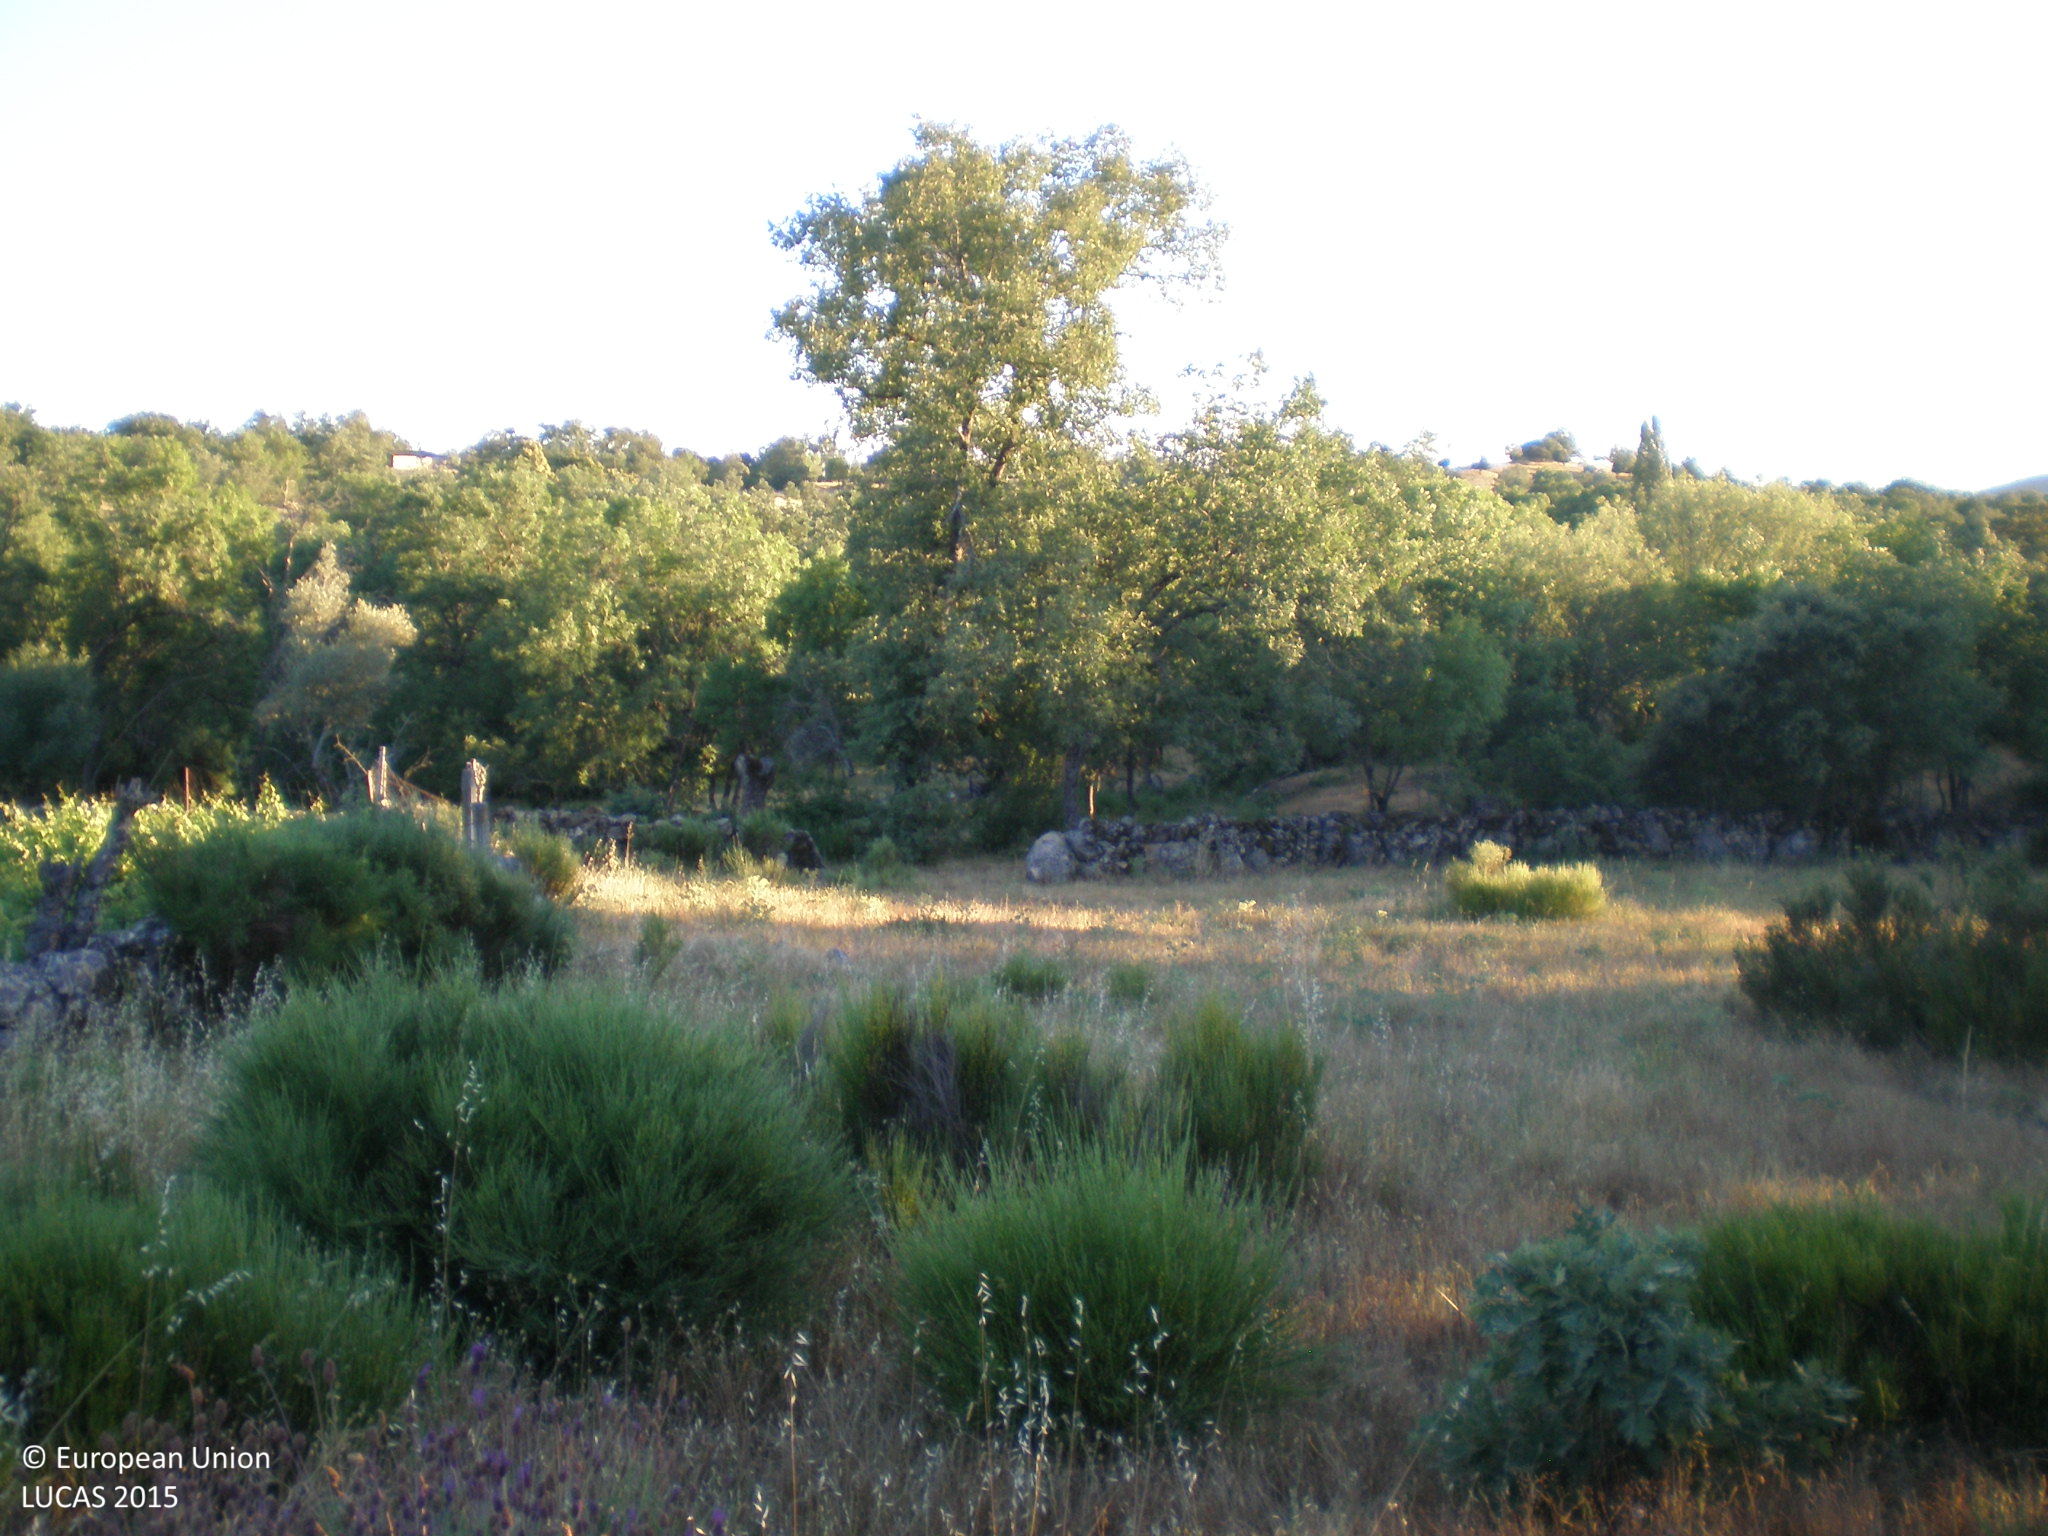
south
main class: Grassland
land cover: Grassland with sparse tree/shrub cover
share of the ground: > 75 %
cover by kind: herbaceous plants 95 %, broadleaved forest trees 5 %
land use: Agriculture (excluding fallow land and kitchen gardens)
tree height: < 5 m
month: June
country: ES
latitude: 40.5391
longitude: -5.8121
